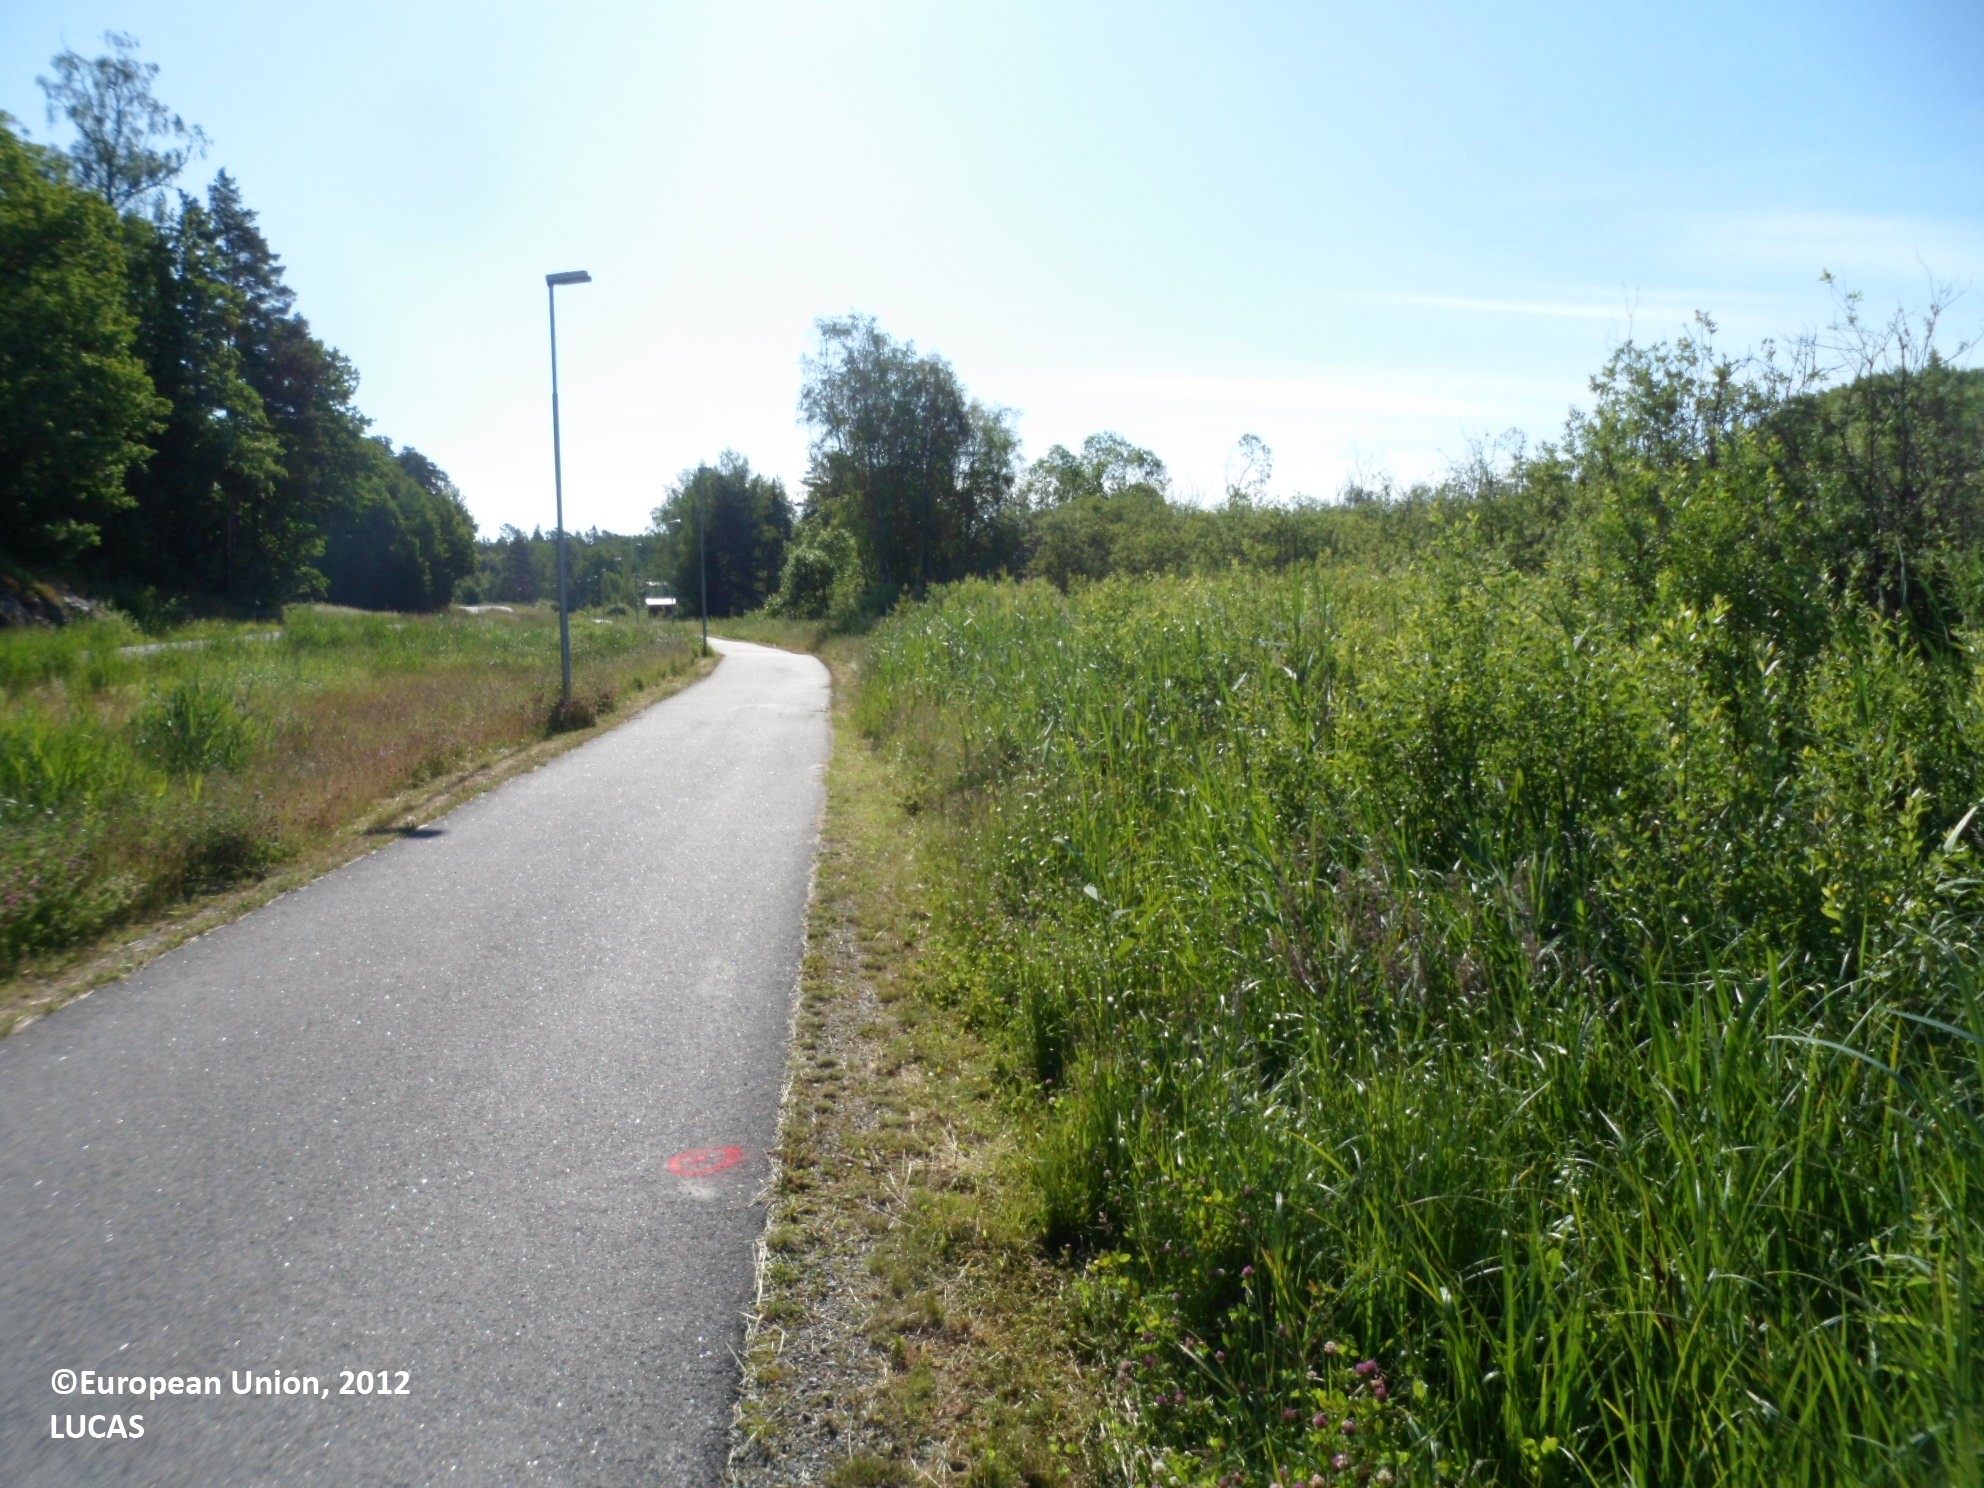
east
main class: Shrubland
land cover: Shrubland with sparse tree cover
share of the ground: > 75 %
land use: Semi-natural and natural areas not in use
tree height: > 5 m
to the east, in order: Shrubland with sparse tree cover
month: July
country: SE
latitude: 59.3246
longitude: 18.5241
